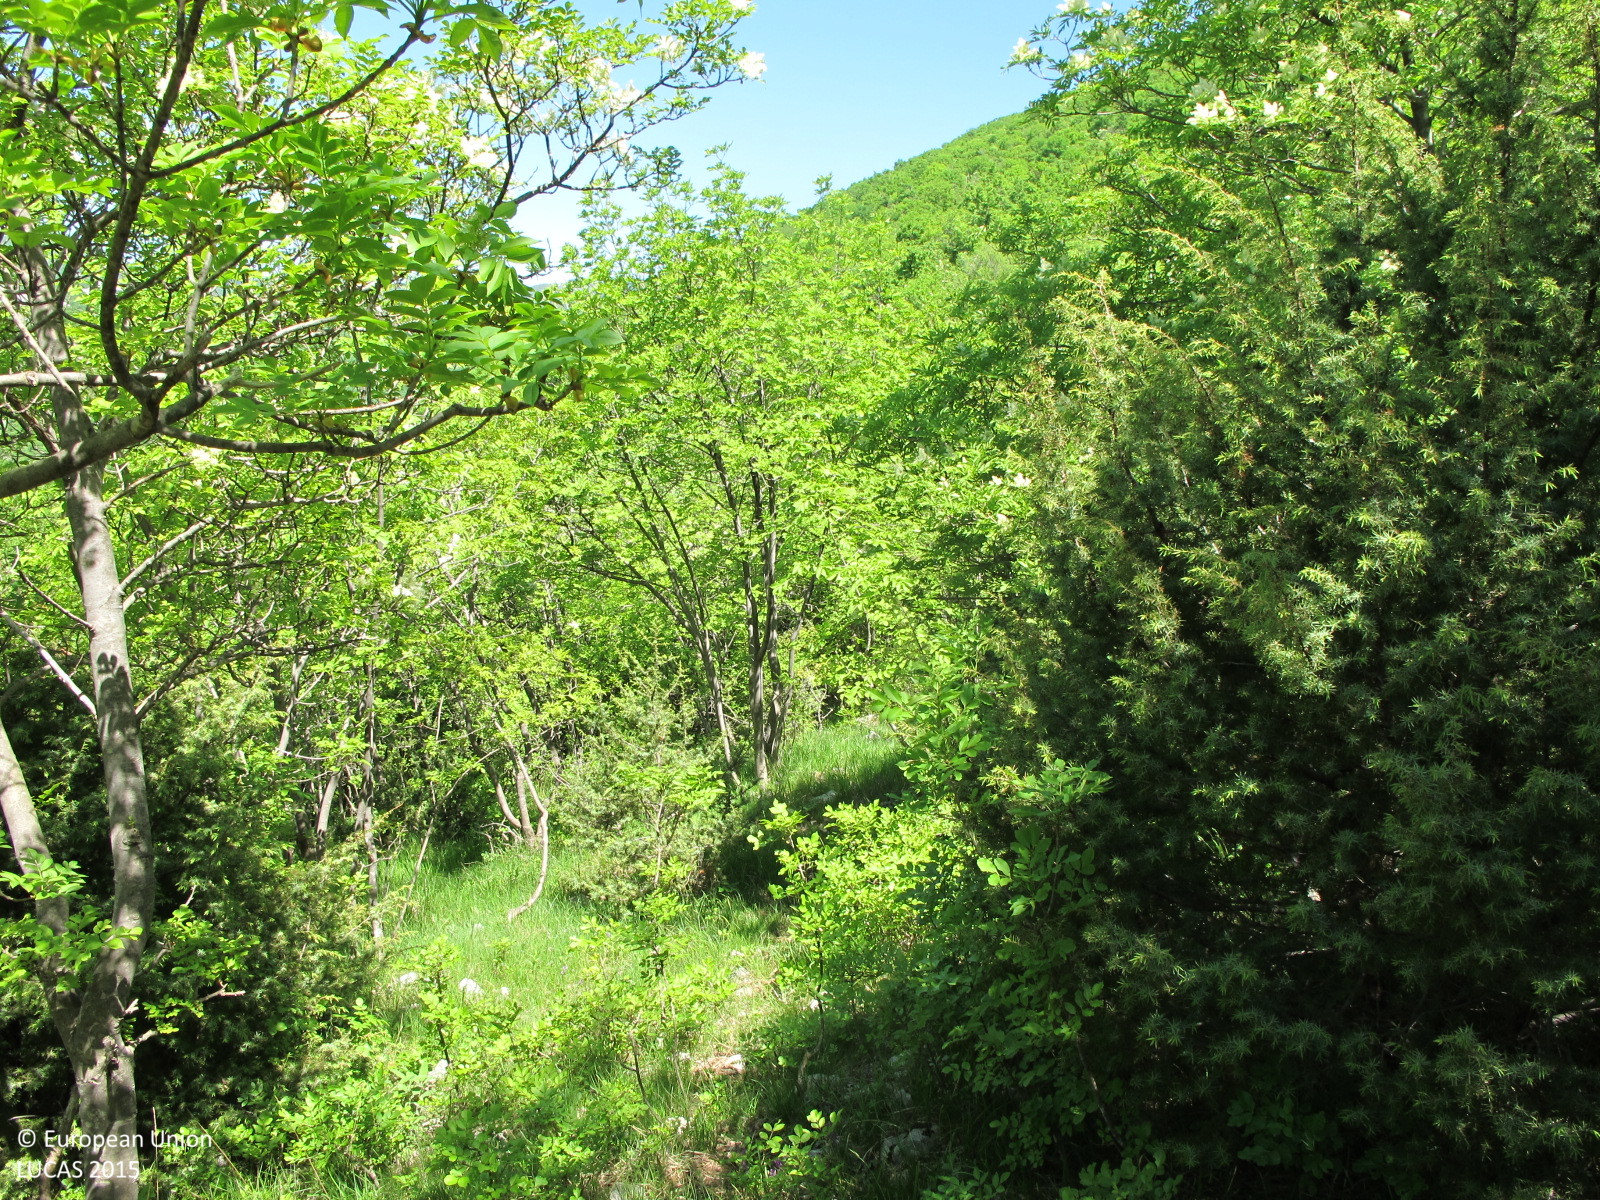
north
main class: Woodland
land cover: Broadleaved woodland
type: mesophytic deciduous forest
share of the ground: > 75 %
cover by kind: broadleaved forest trees 70 %, coniferous forest trees 10 %, shrubs 10 %, herbaceous plants 5 %, consolidated bare surface 5 %
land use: Forestry
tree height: < 5 m
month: May
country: HR
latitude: 45.1587
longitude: 14.8414
